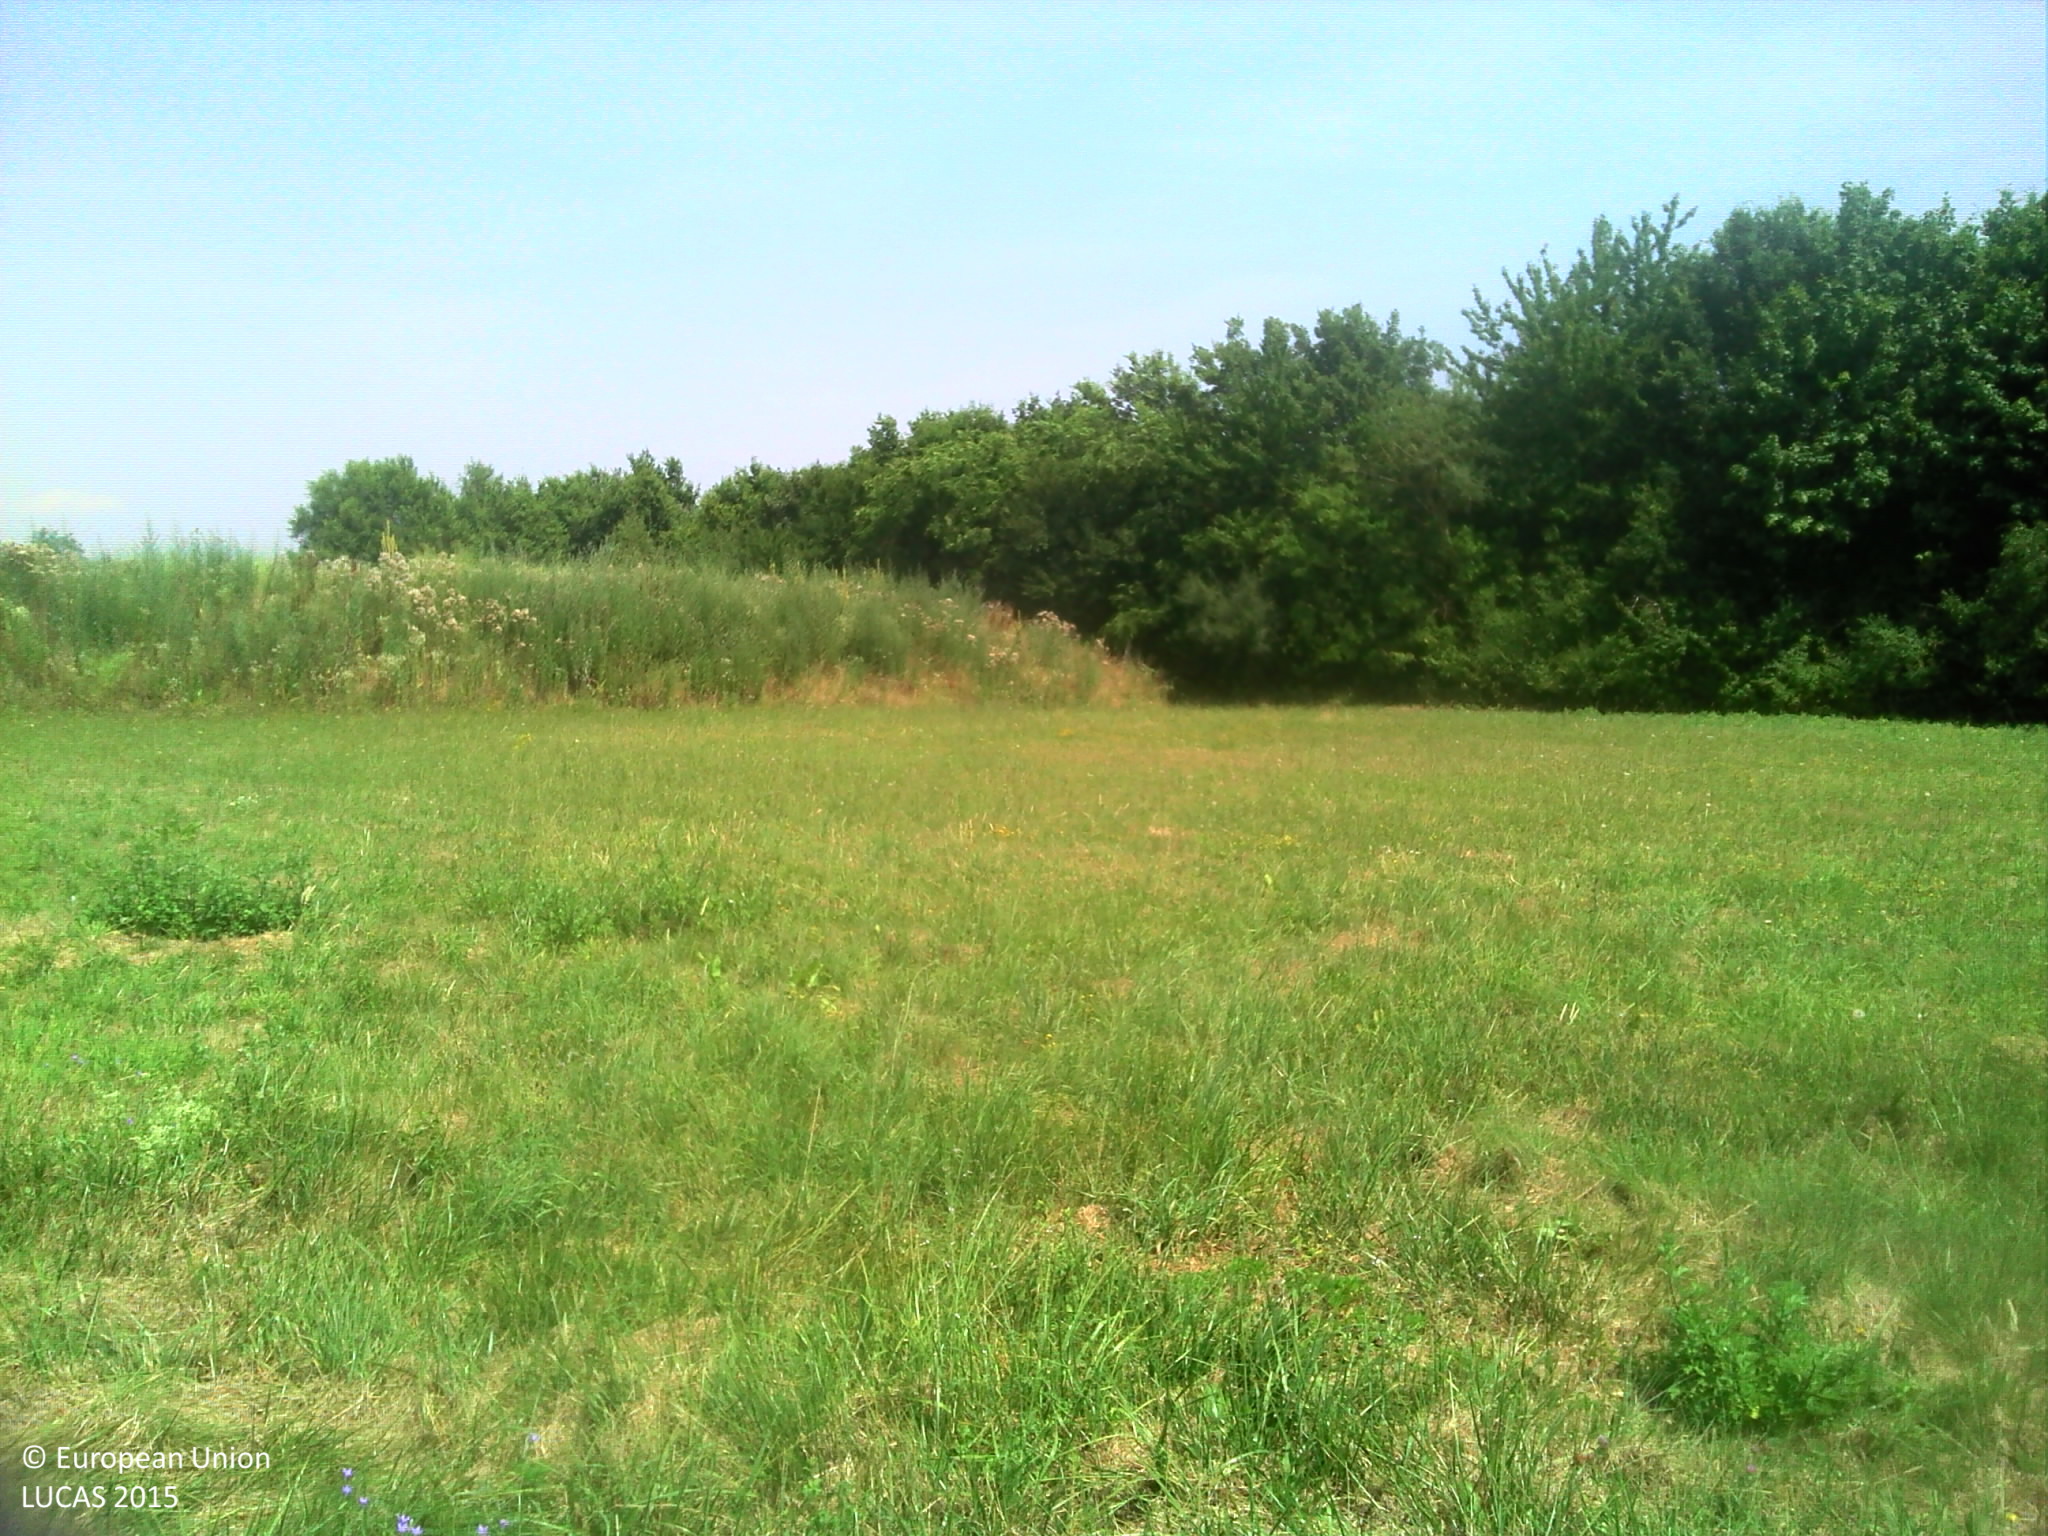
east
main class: Grassland
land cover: Grassland without tree/shrub cover
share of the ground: > 75 %
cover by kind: herbaceous plants 100 %
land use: Agriculture (excluding fallow land and kitchen gardens)
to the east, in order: Grassland without tree/shrub cover; Spontaneously vegetated surfaces; Broadleaved woodland; Grass margins; Paved roads, cycling and walking lanes; Grass margins; Electric lines; Maize; Spontaneously vegetated surfaces
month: July
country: FR
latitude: 45.7543
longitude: 5.1573
